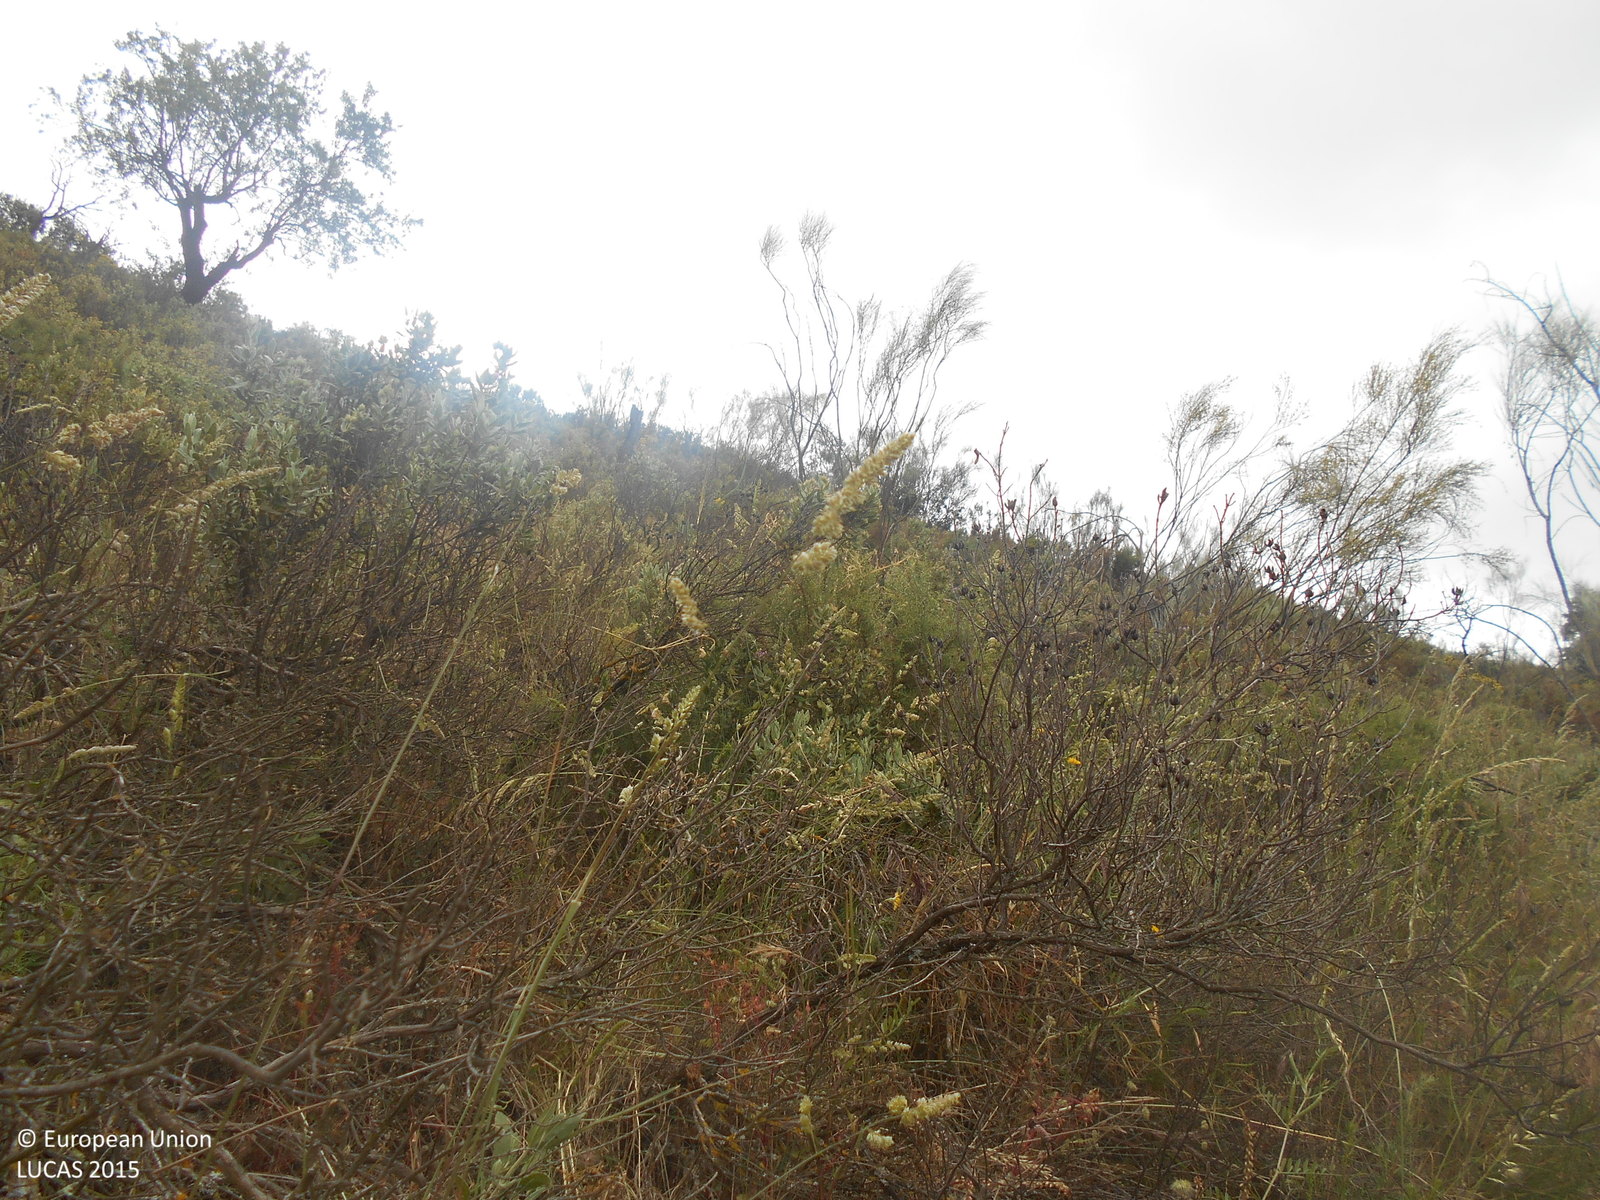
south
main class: Shrubland
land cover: Shrubland with sparse tree cover
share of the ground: > 75 %
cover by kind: shrubs 80 %, herbaceous plants 15 %, broadleaved forest trees 5 %
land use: Semi-natural and natural areas not in use
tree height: < 5 m
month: May
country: ES
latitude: 37.2175
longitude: -2.1836
